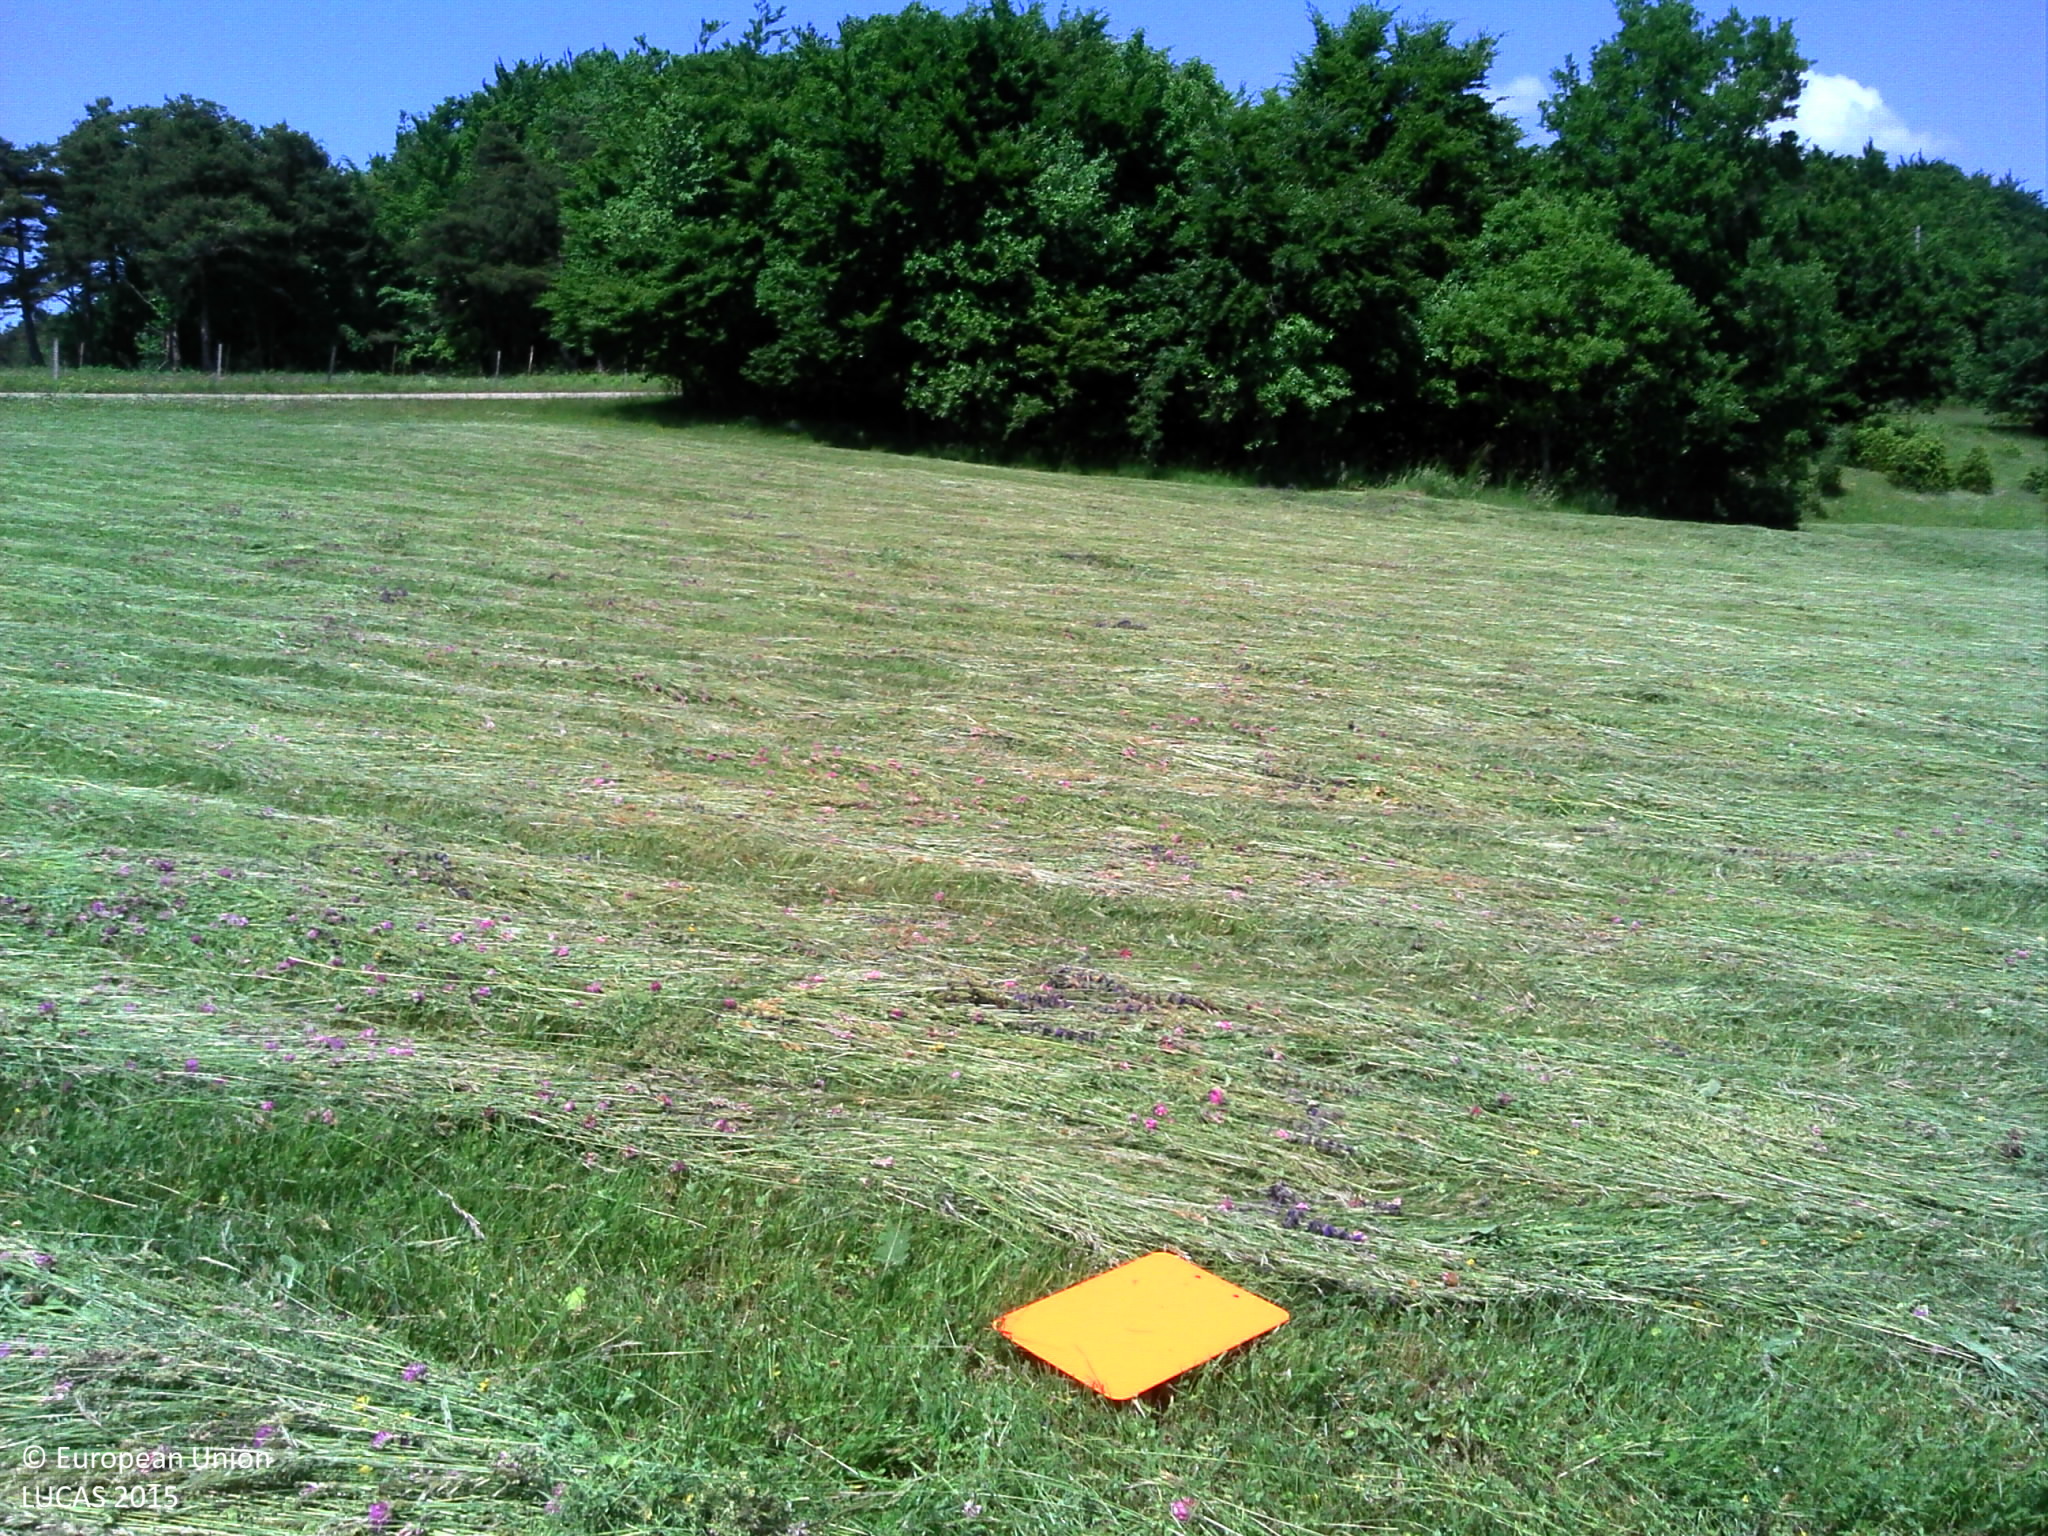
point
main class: Grassland
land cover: Grassland without tree/shrub cover
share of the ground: > 75 %
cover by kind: herbaceous plants 100 %
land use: Agriculture (excluding fallow land and kitchen gardens)
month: June
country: FR
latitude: 44.8518
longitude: 5.1599
